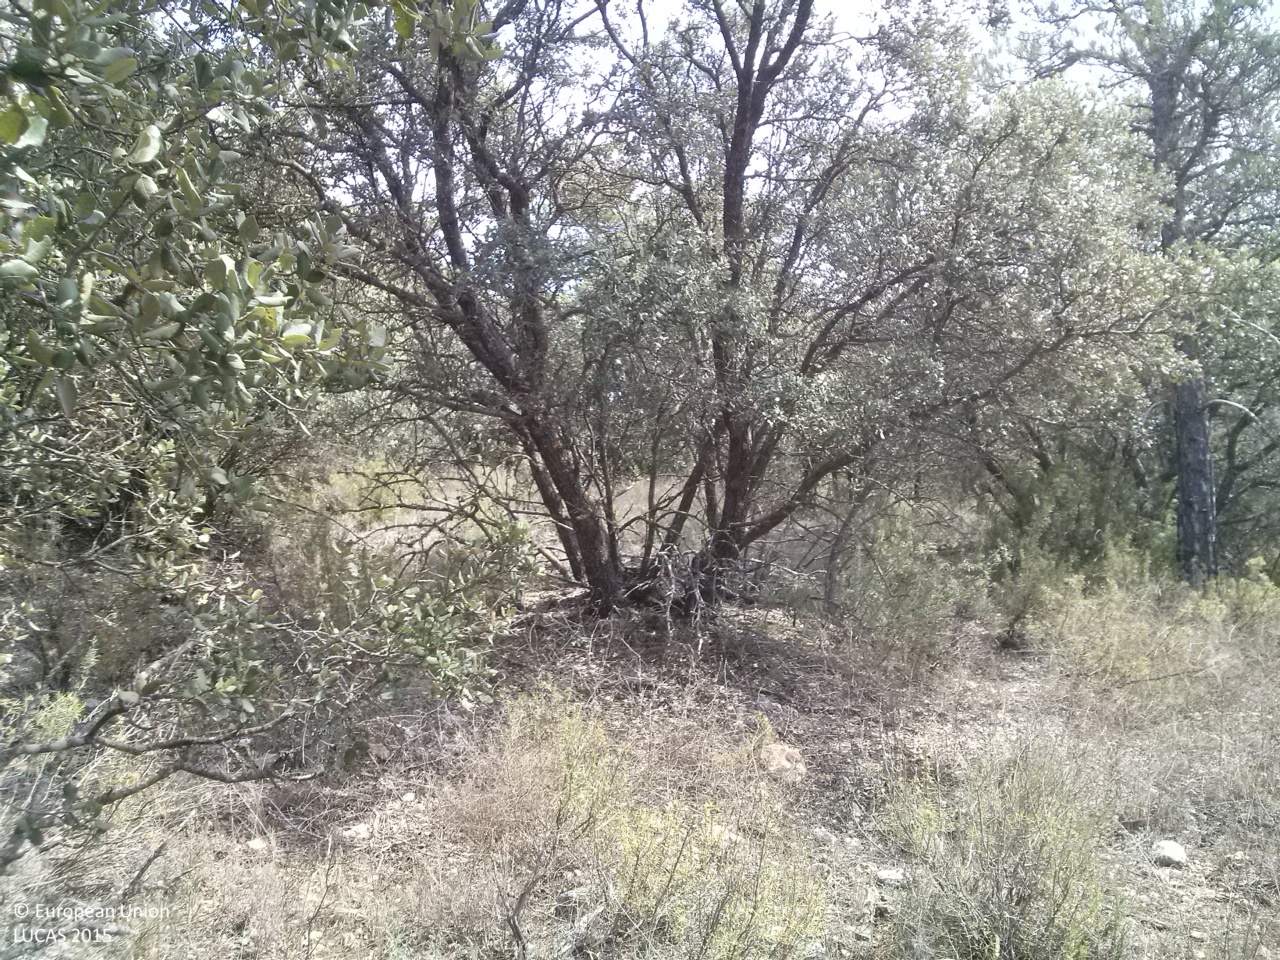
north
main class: Woodland
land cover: Other mixed woodland
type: broadleaved evergreen forest
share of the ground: 50 - 75 %
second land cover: Shrubland without tree cover
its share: 10 - 25 %
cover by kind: broadleaved forest trees 45 %, coniferous forest trees 25 %, shrubs 20 %, herbaceous plants 10 %
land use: Forestry
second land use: Agriculture (excluding fallow land and kitchen gardens)
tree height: > 5 m
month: June
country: ES
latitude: 39.9668
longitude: -1.8485
